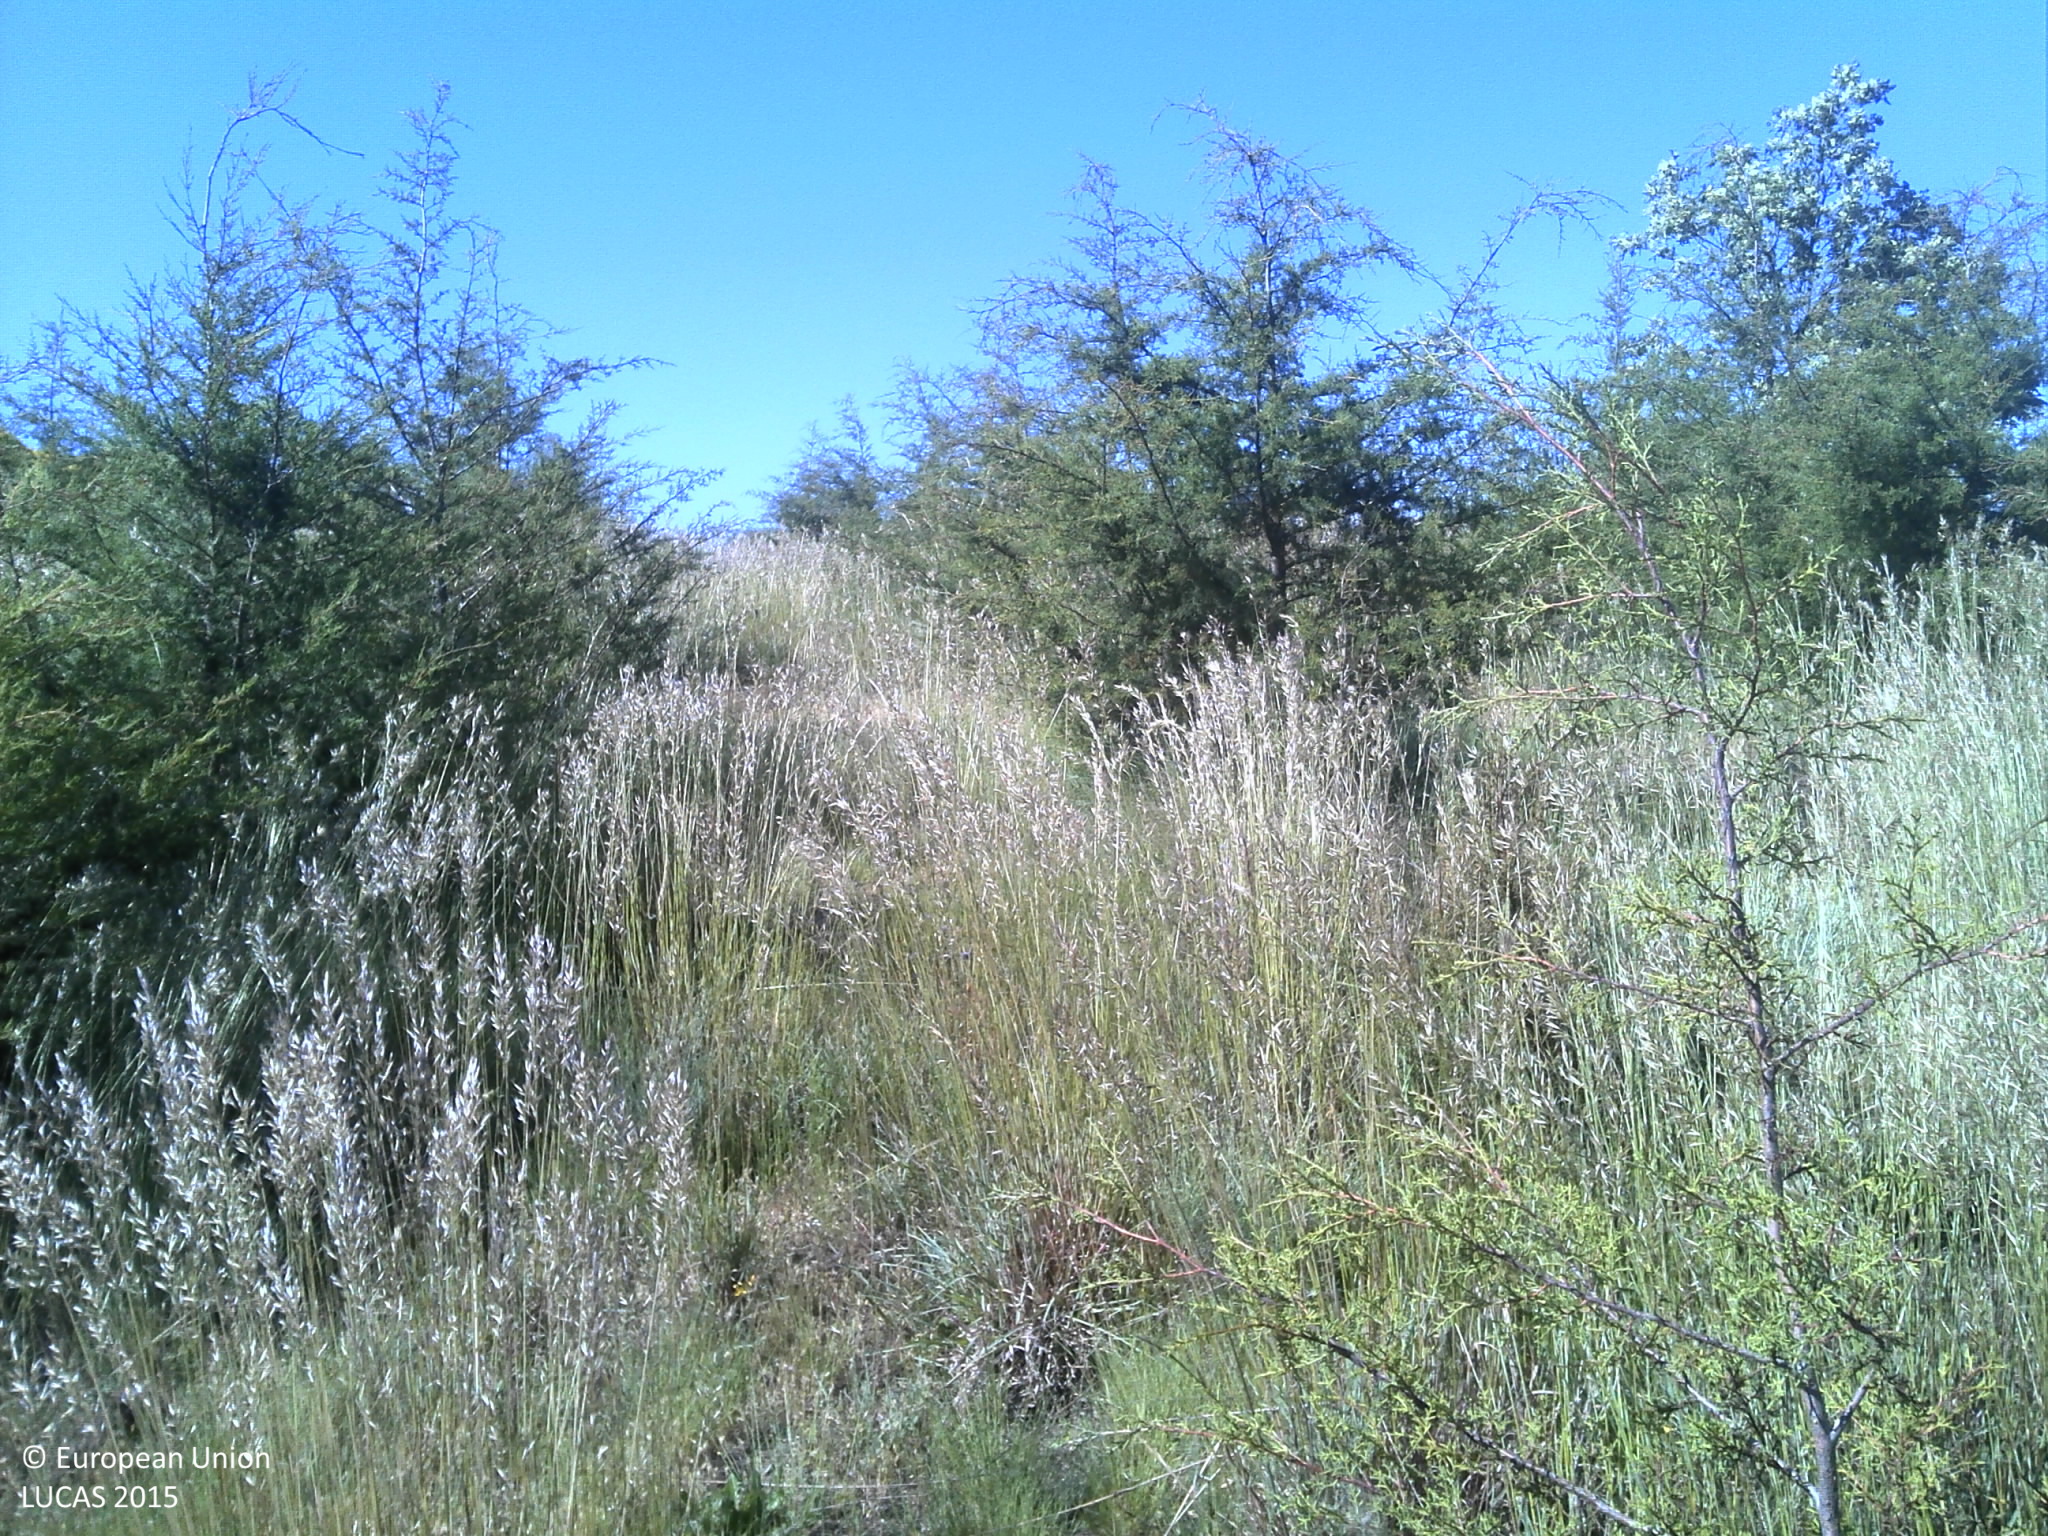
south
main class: Woodland
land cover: Other coniferous woodland
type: coniferous forest of the mediterranean region
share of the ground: 10 - 25 %
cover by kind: coniferous forest trees 25 %, shrubs 25 %, consolidated bare surface 25 %, herbaceous plants 20 %, unconsolidated bare surface 5 %
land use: Forestry
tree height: < 5 m
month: May
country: PT
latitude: 40.6015
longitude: -7.1813
